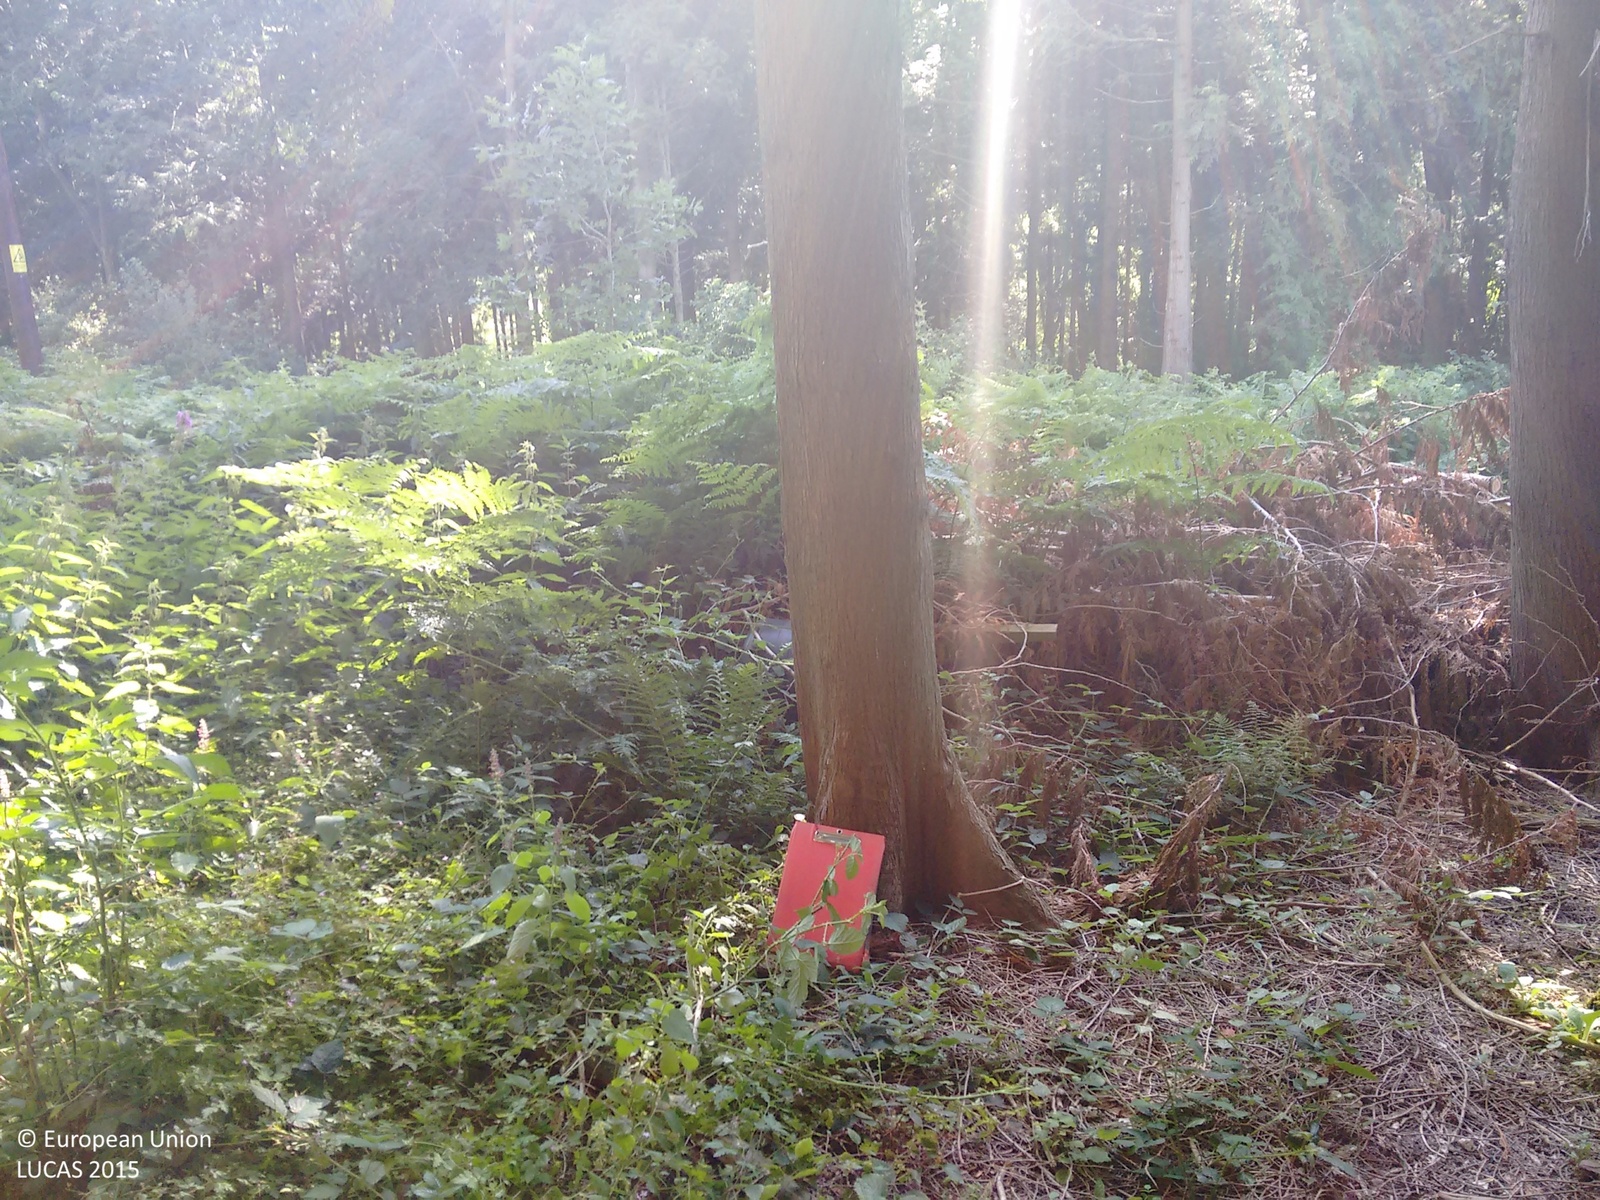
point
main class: Woodland
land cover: Other coniferous woodland
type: exotic forest
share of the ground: > 75 %
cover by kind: coniferous forest trees 100 %
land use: Forestry
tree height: > 5 m
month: July
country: GB
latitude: 50.9481
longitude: -0.9035
